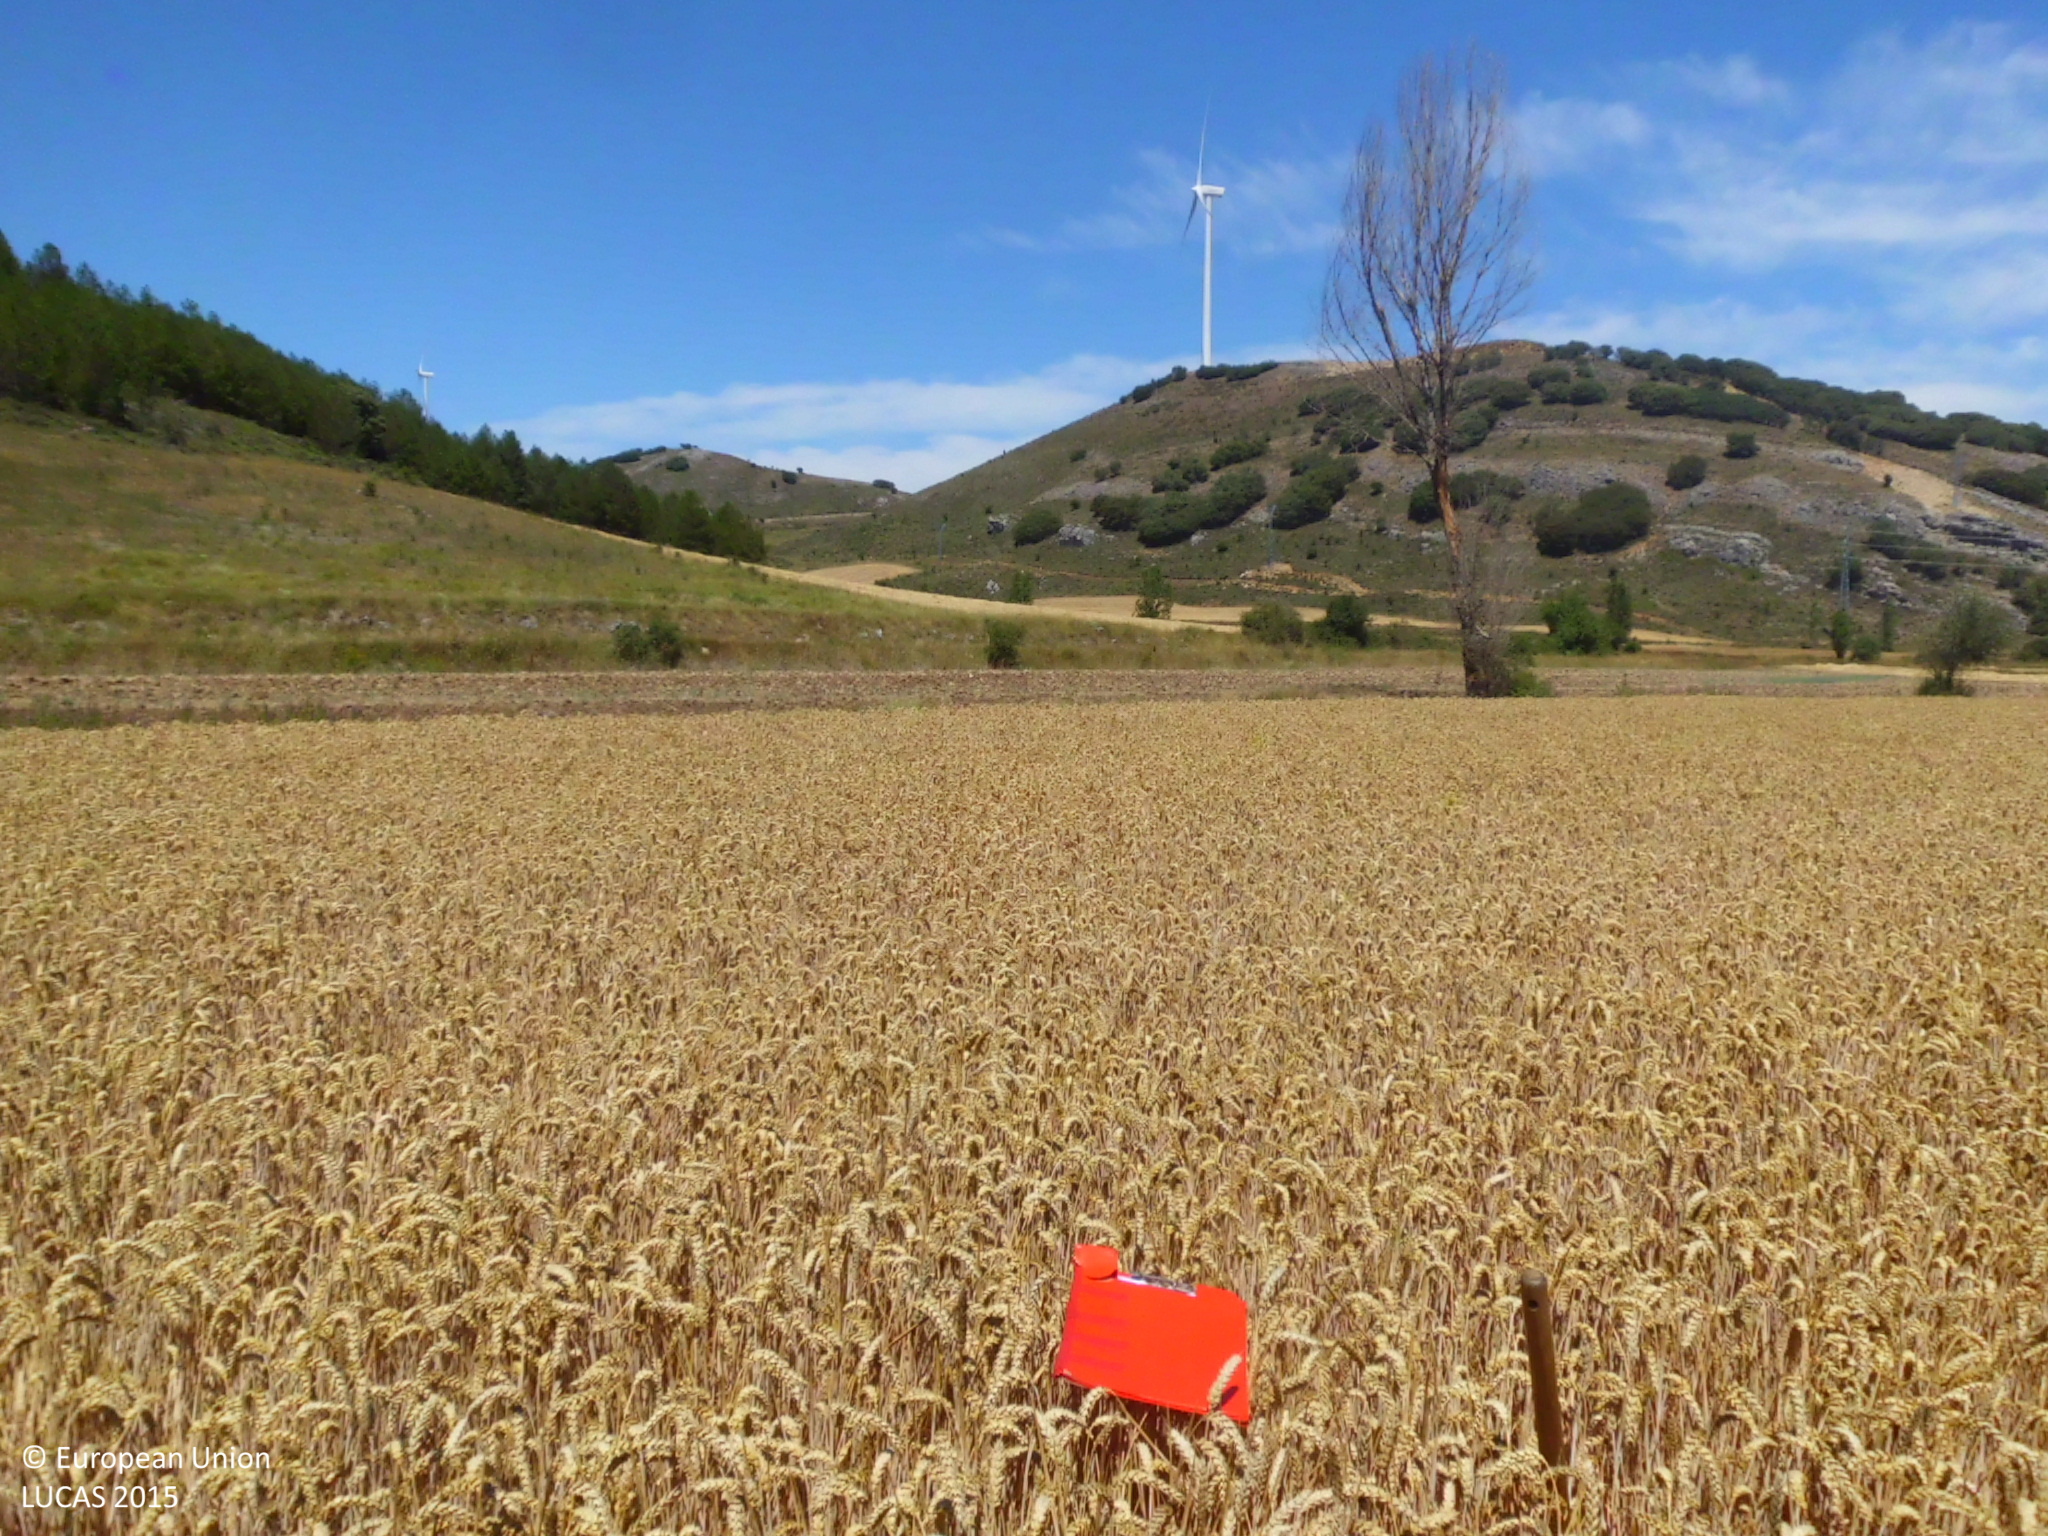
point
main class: Cropland
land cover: Common wheat
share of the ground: > 75 %
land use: Agriculture (excluding fallow land and kitchen gardens)
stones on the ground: < 10 %
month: July
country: ES
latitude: 42.7457
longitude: -4.3319
